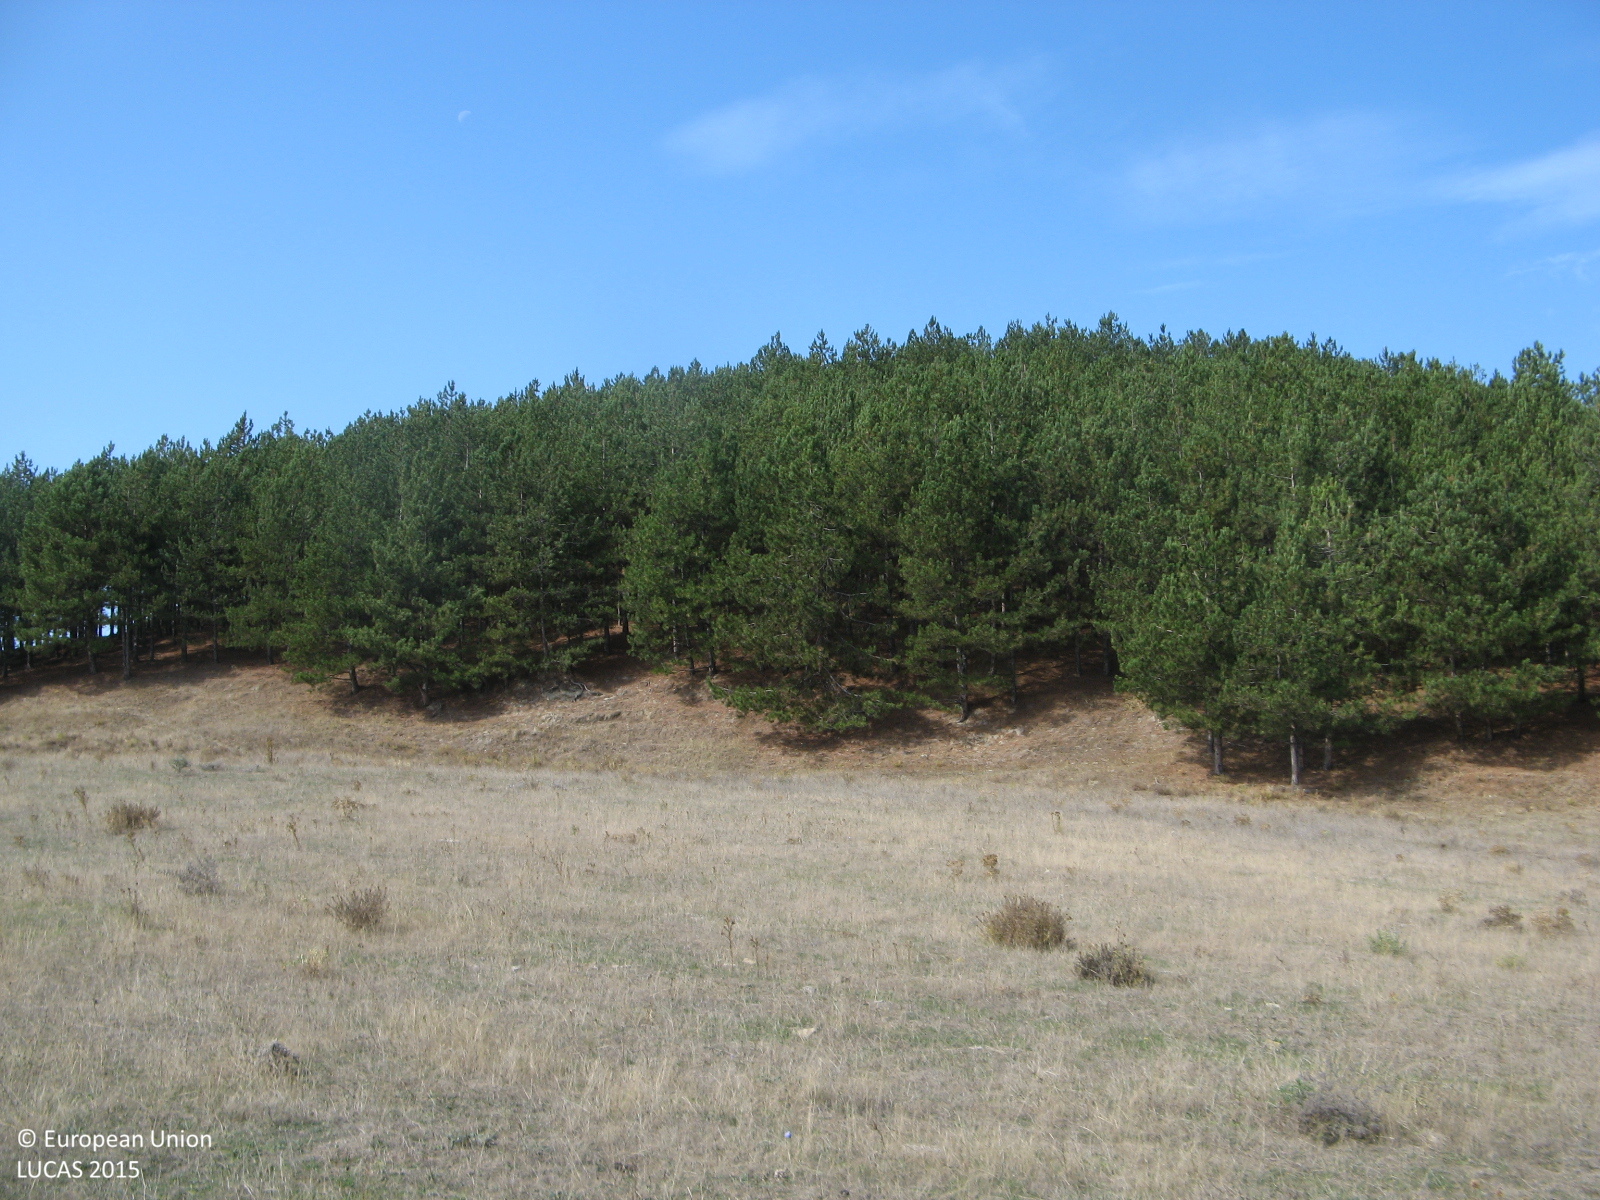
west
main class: Grassland
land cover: Grassland without tree/shrub cover
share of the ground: > 75 %
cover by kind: herbaceous plants 100 %
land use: Agriculture (excluding fallow land and kitchen gardens)
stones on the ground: < 10 %
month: October
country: BG
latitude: 41.6530
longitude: 25.3913
